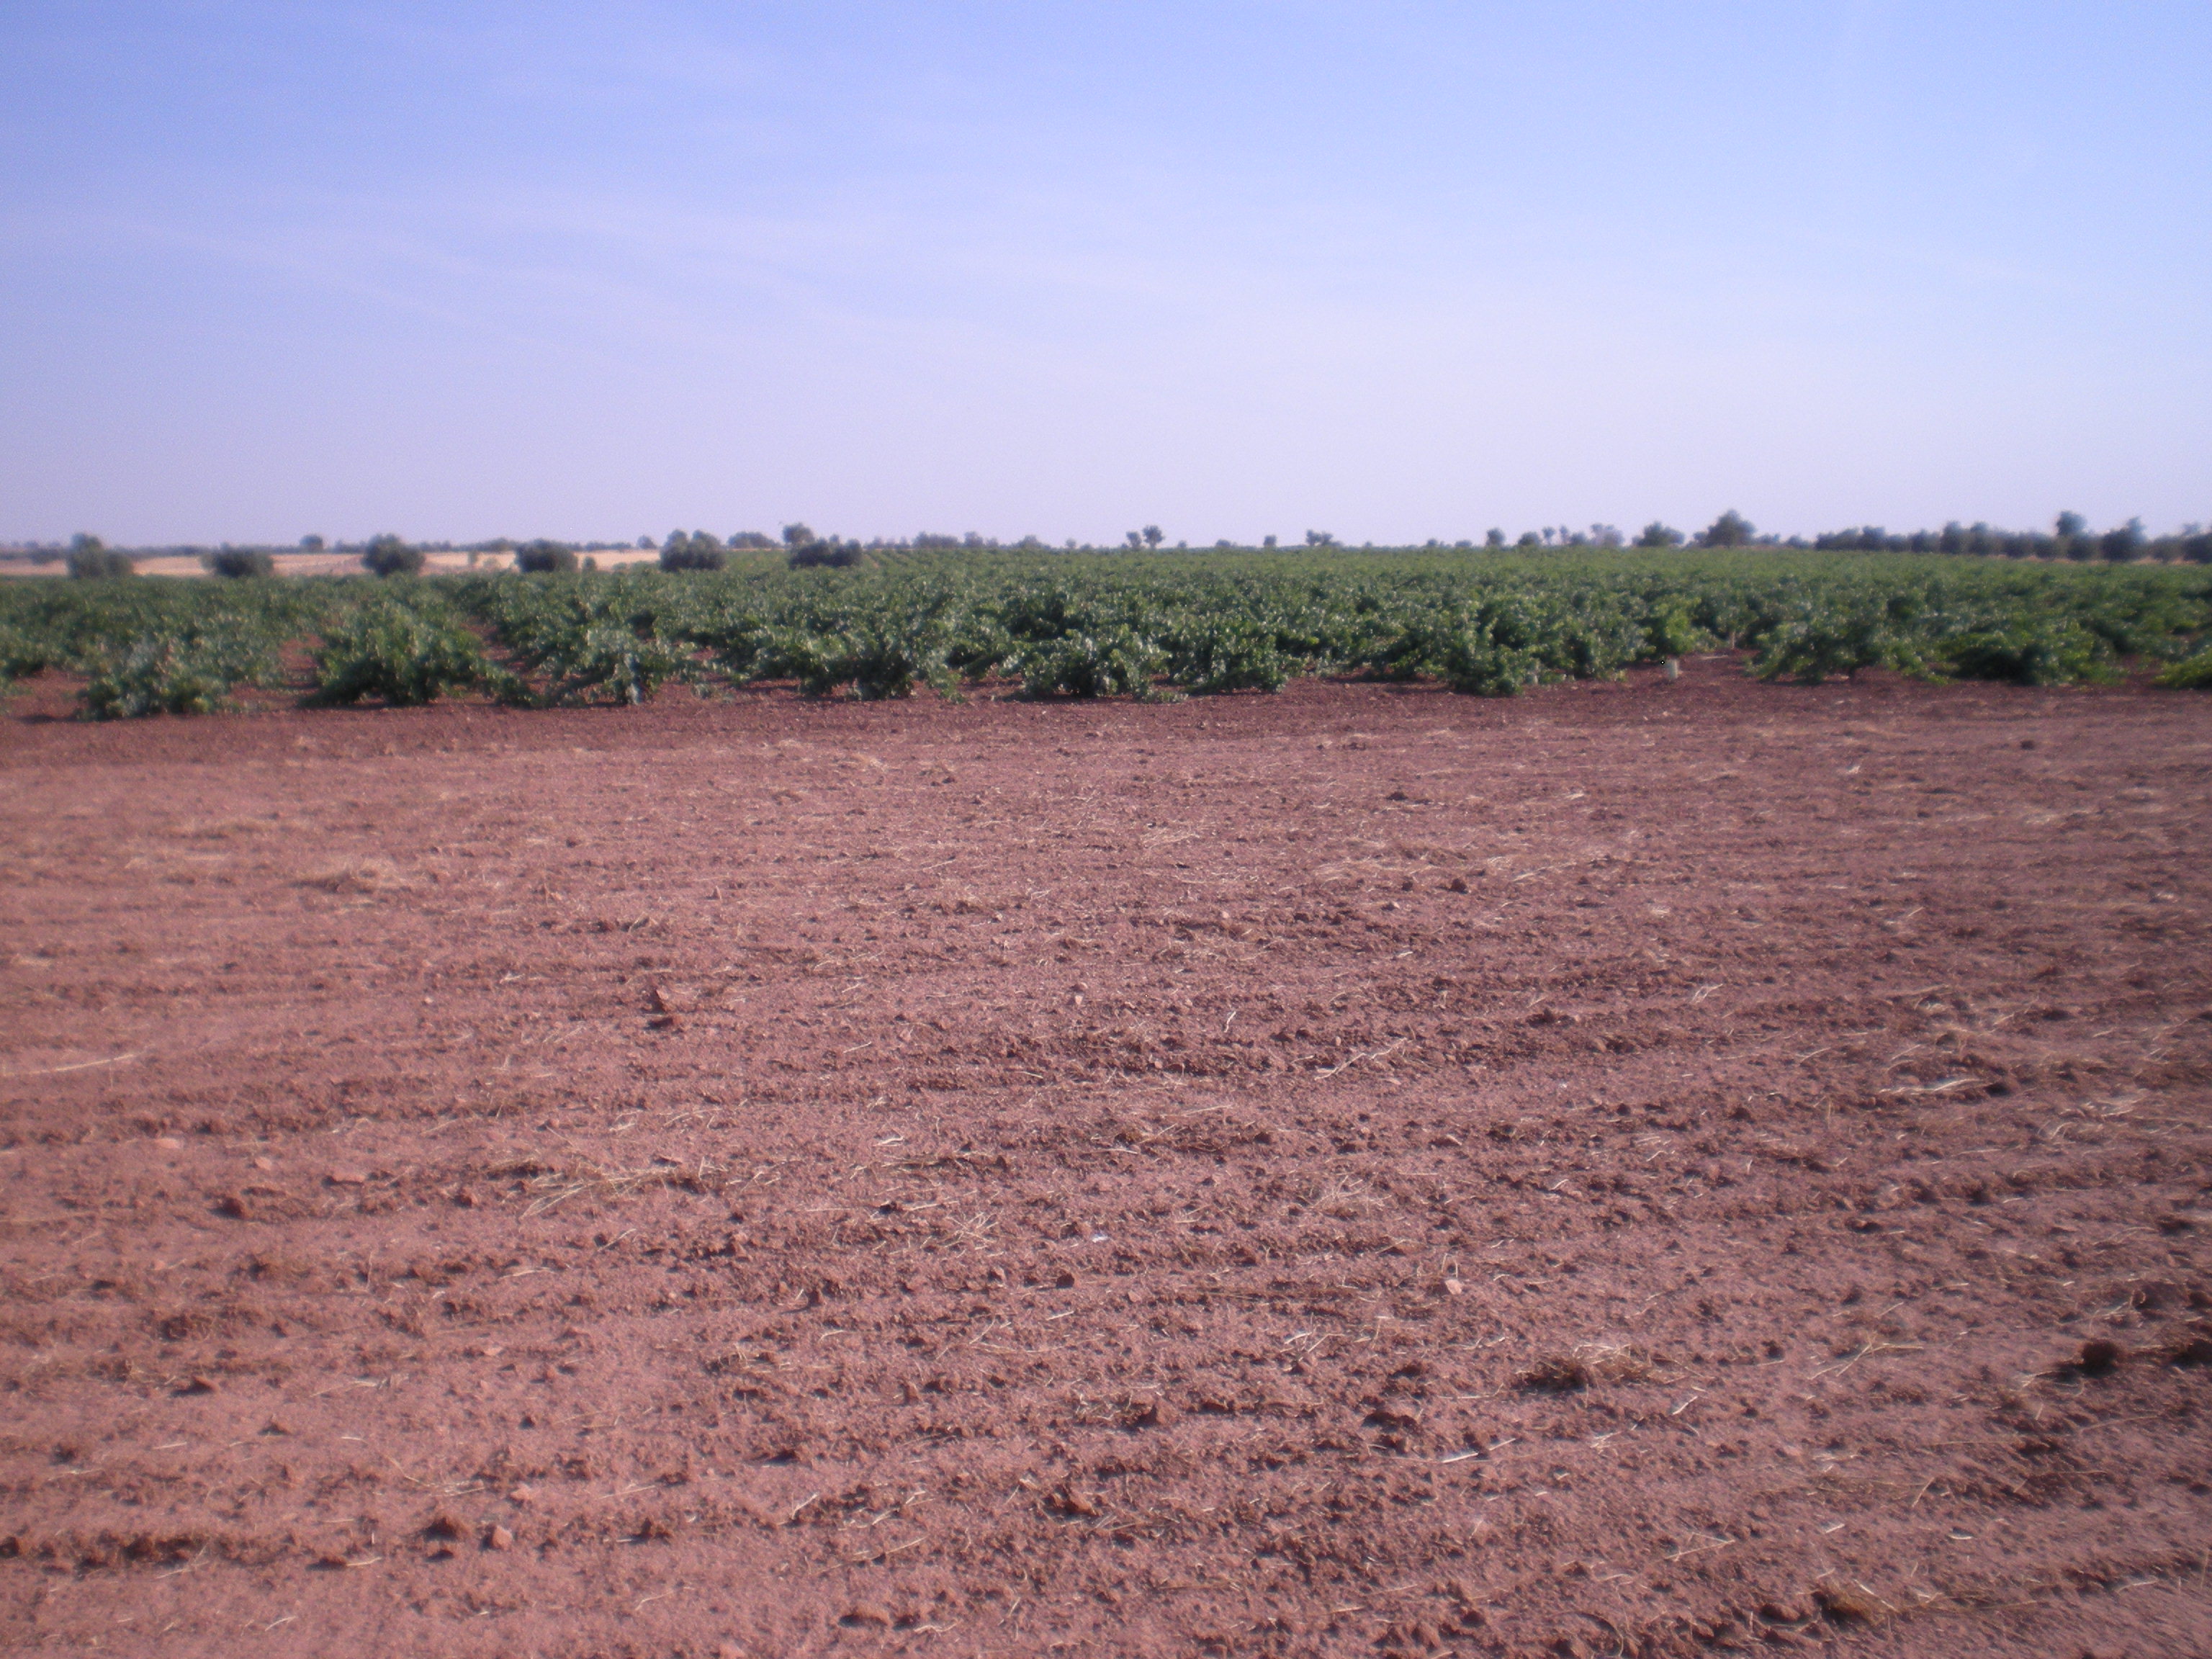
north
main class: Grassland
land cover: Spontaneously vegetated surfaces
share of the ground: 10 - 25 %
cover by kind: unconsolidated bare surface 85 %, herbaceous plants 15 %
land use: Fallow land
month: July
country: ES
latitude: 39.4087
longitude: -3.0588
